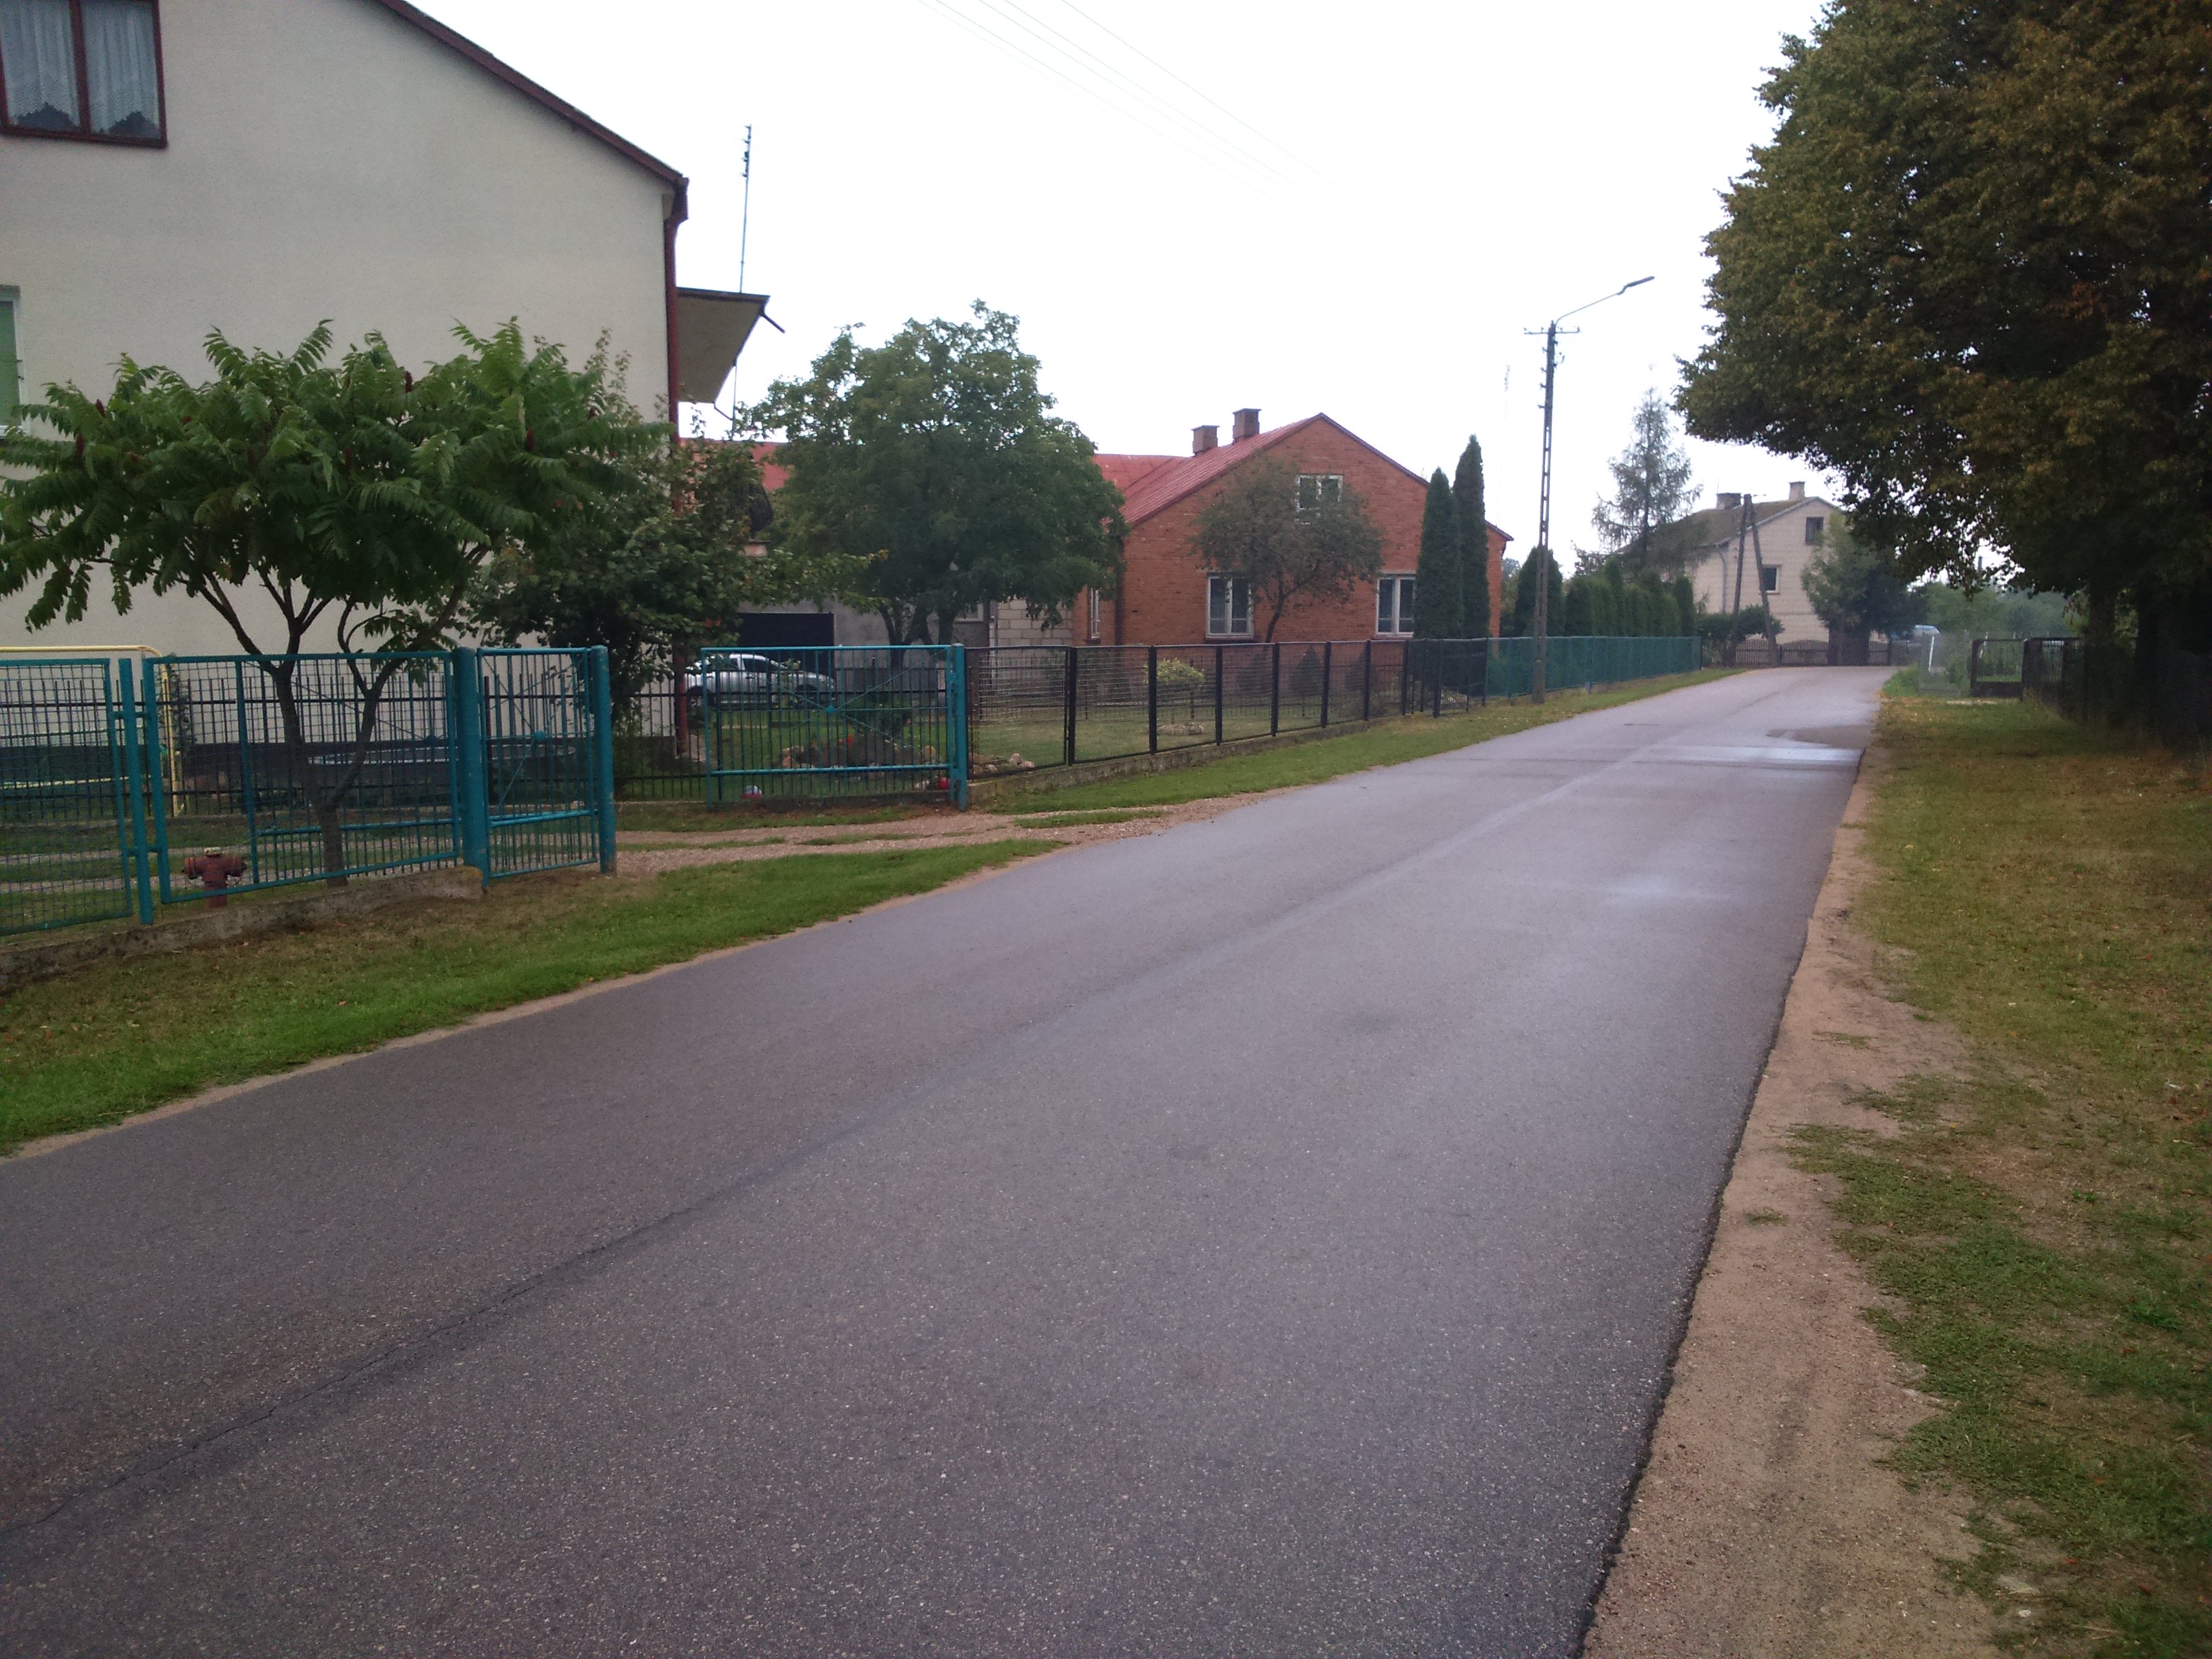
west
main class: Grassland
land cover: Grassland with sparse tree/shrub cover
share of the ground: > 75 %
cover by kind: herbaceous plants 90 %, broadleaved forest trees 5 %, shrubs 5 %
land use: Road transport
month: September
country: PL
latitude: 52.3809
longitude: 22.2111
